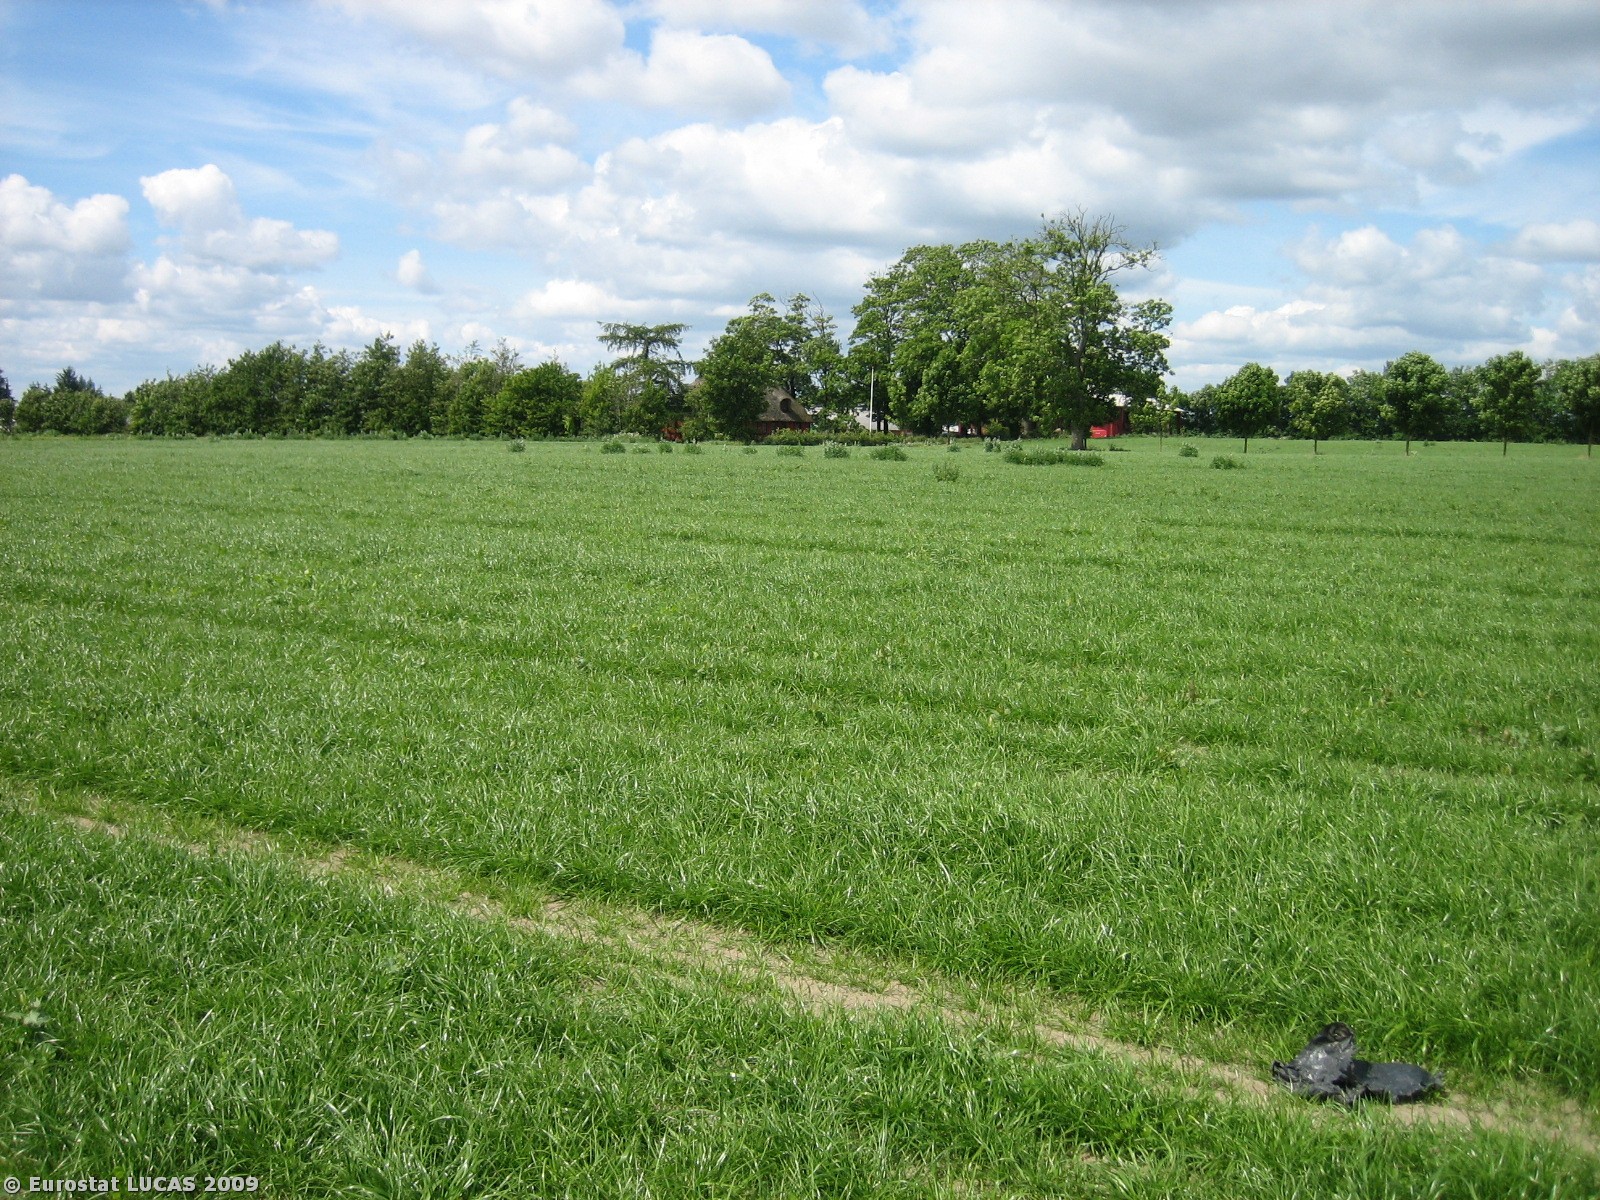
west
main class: Cropland
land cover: Temporary grasslands
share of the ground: 50 - 75 %
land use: Agriculture (excluding fallow land and kitchen gardens)
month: June
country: DK
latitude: 56.0617
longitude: 9.7915
